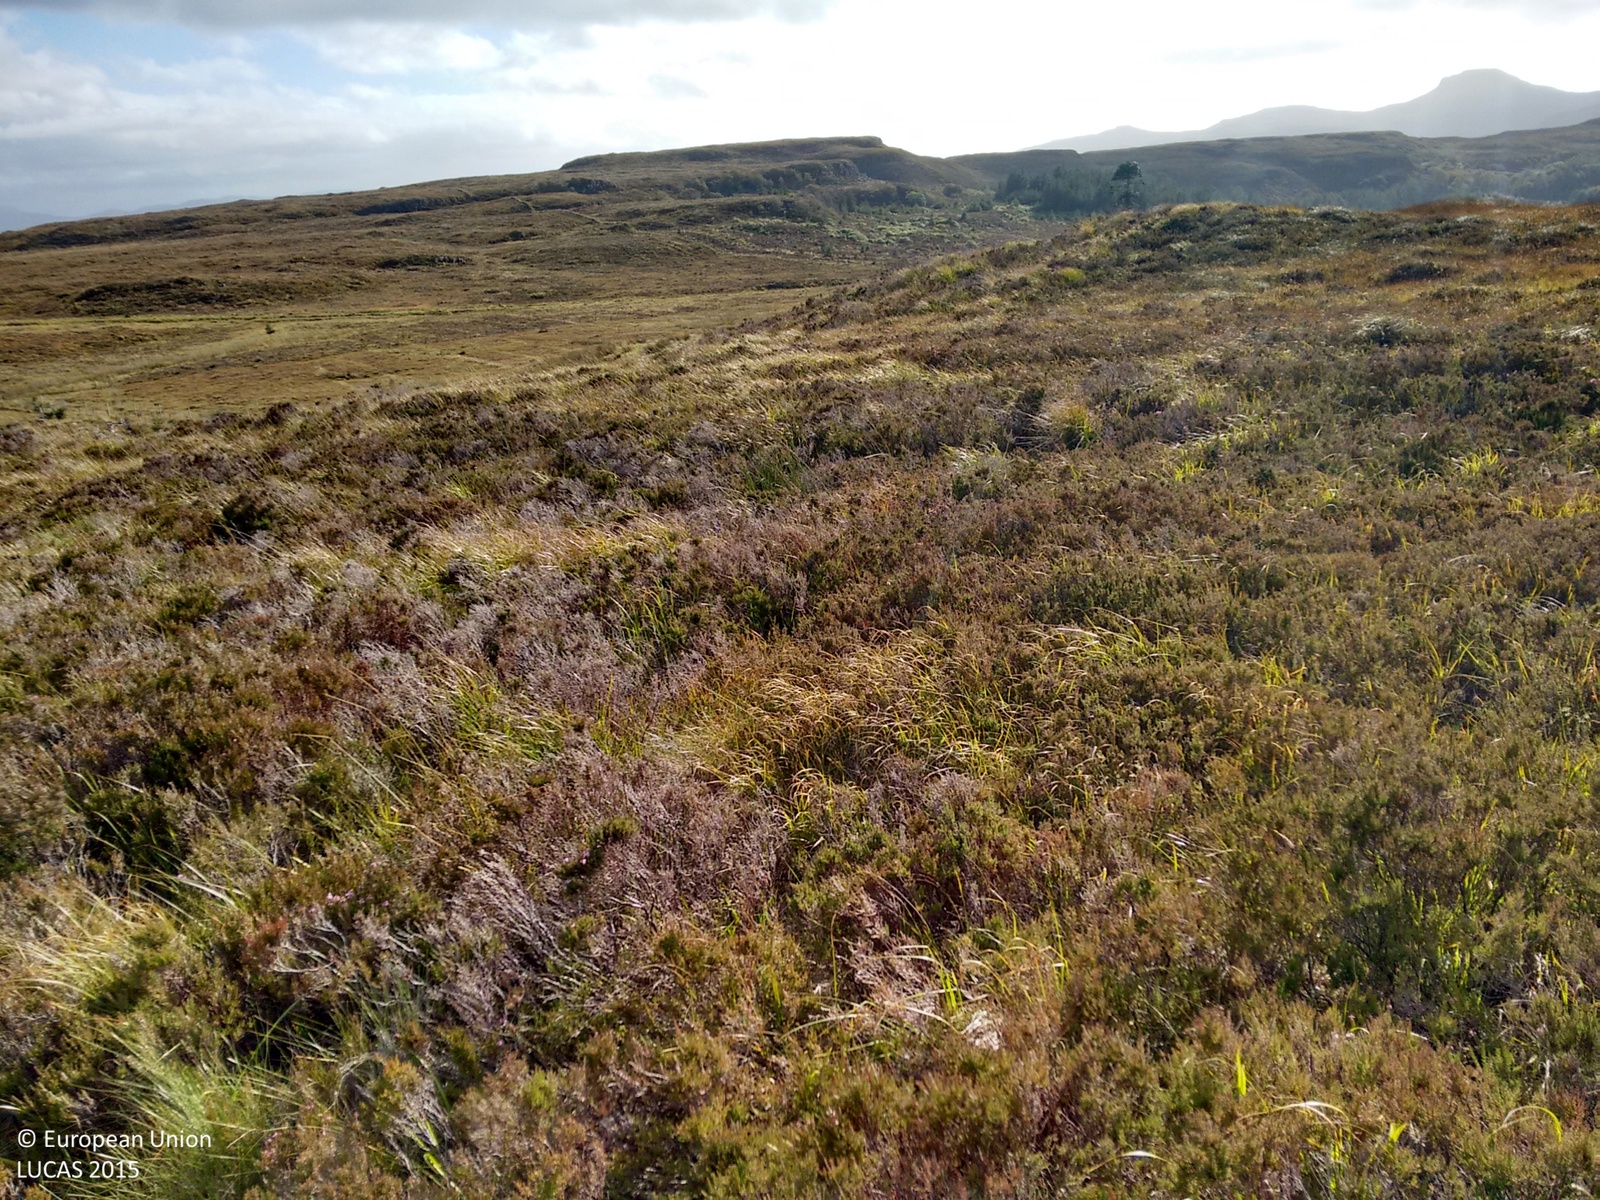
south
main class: Shrubland
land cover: Shrubland without tree cover
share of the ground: > 75 %
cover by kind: shrubs 90 %, herbaceous plants 10 %
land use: Semi-natural and natural areas not in use
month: September
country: GB
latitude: 57.4570
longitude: -6.5623
